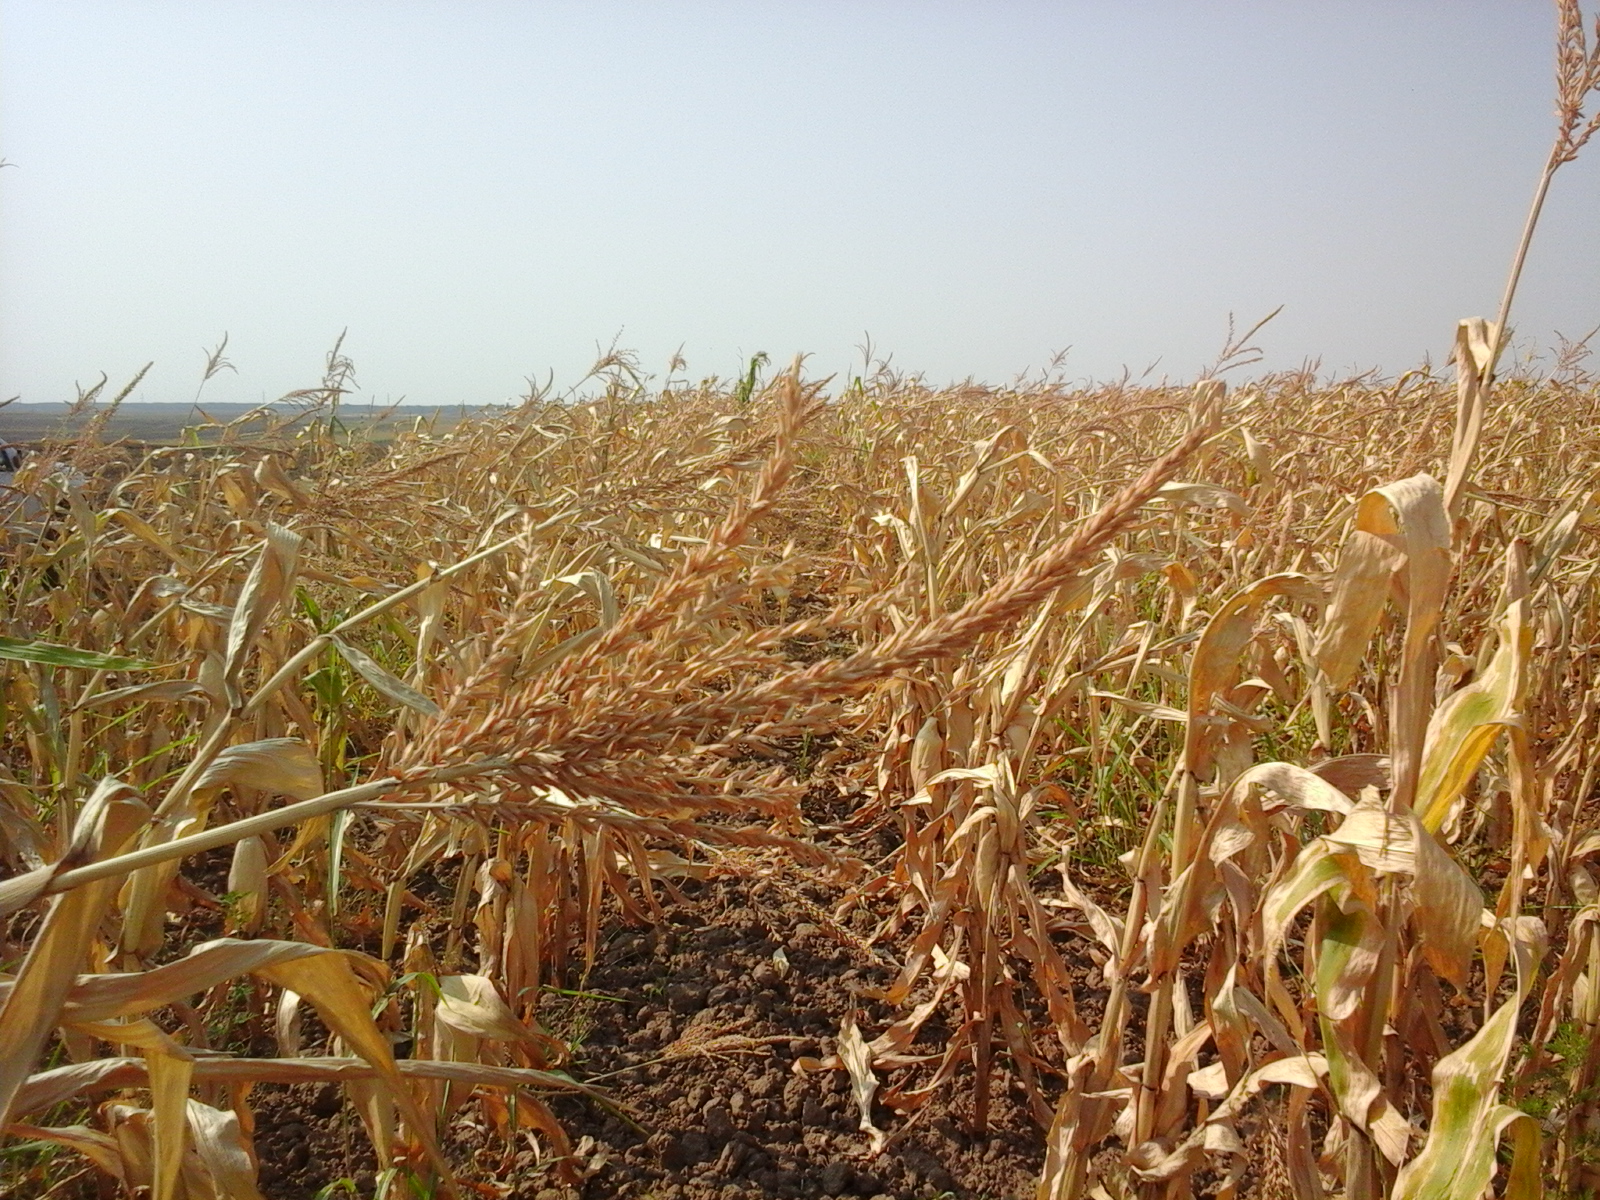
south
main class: Cropland
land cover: Maize
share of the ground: > 75 %
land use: Agriculture (excluding fallow land and kitchen gardens)
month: August
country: RO
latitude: 44.3158
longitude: 22.6899
